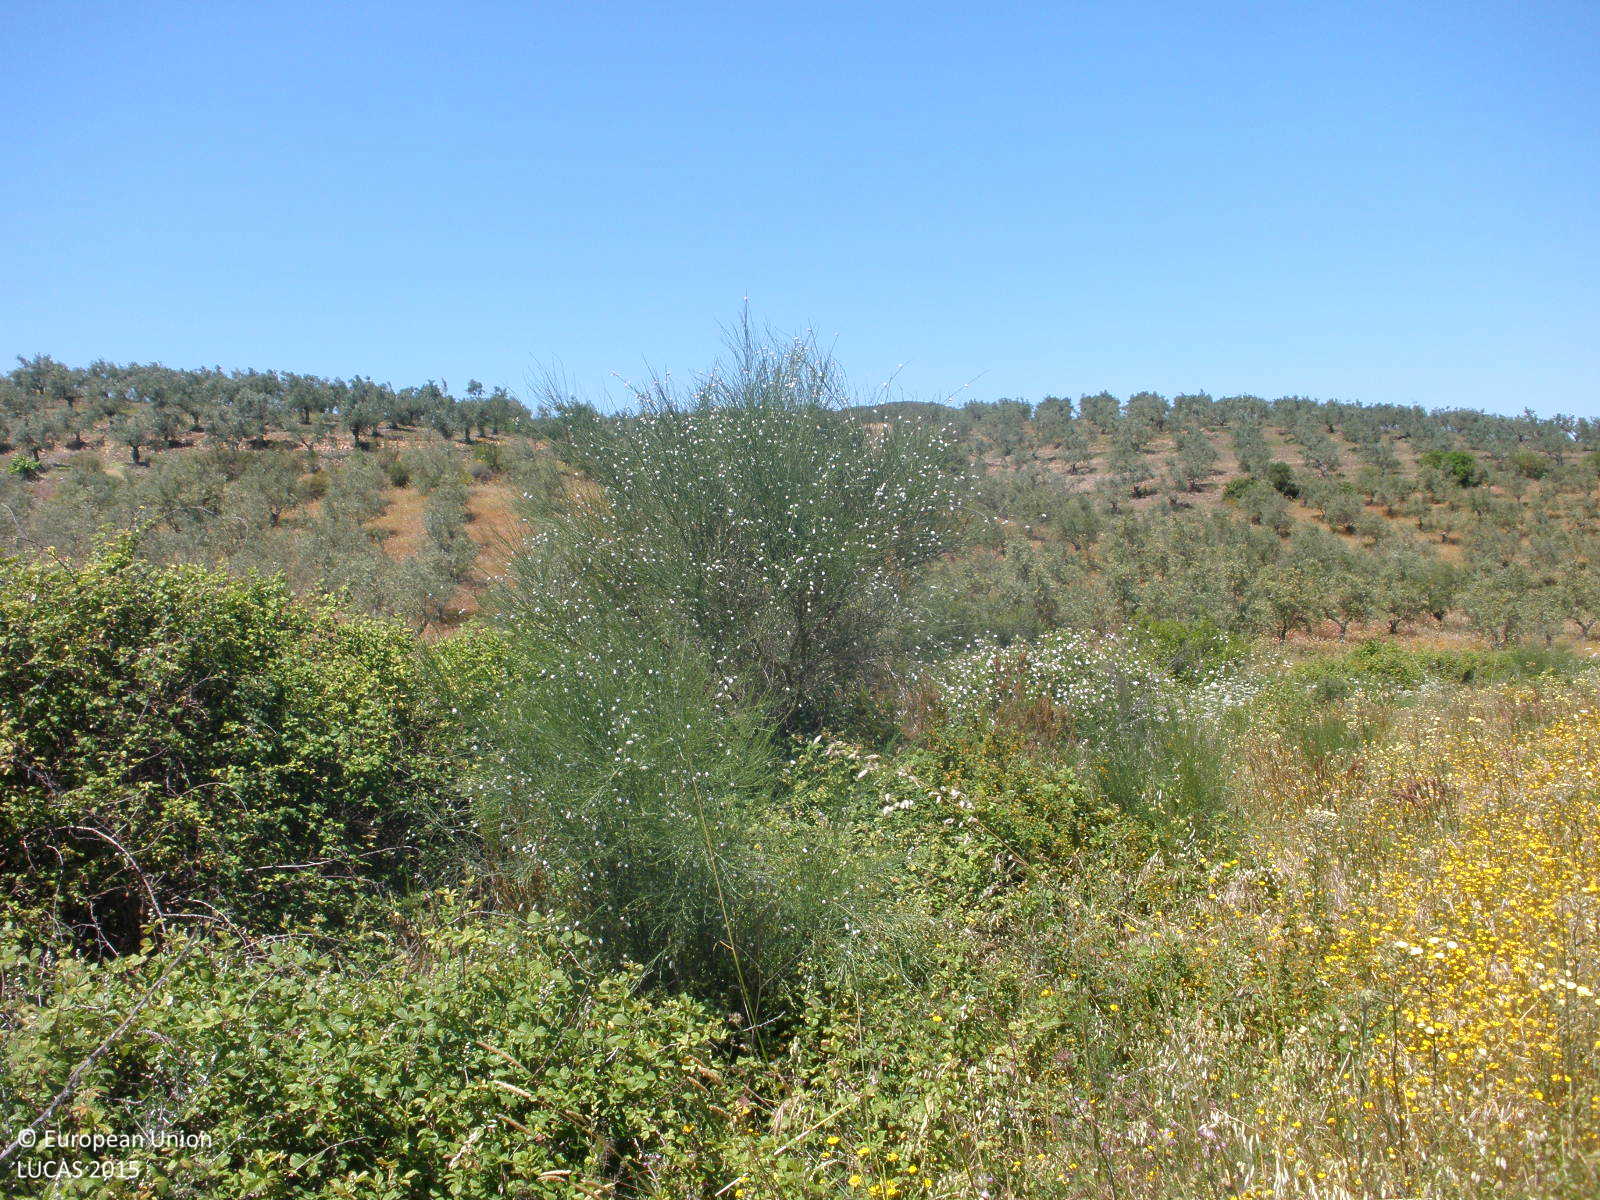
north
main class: Shrubland
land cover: Shrubland without tree cover
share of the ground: > 75 %
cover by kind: shrubs 90 %, herbaceous plants 10 %
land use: Semi-natural and natural areas not in use
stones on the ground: > 50 %
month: May
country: ES
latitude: 40.3196
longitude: -6.1408
